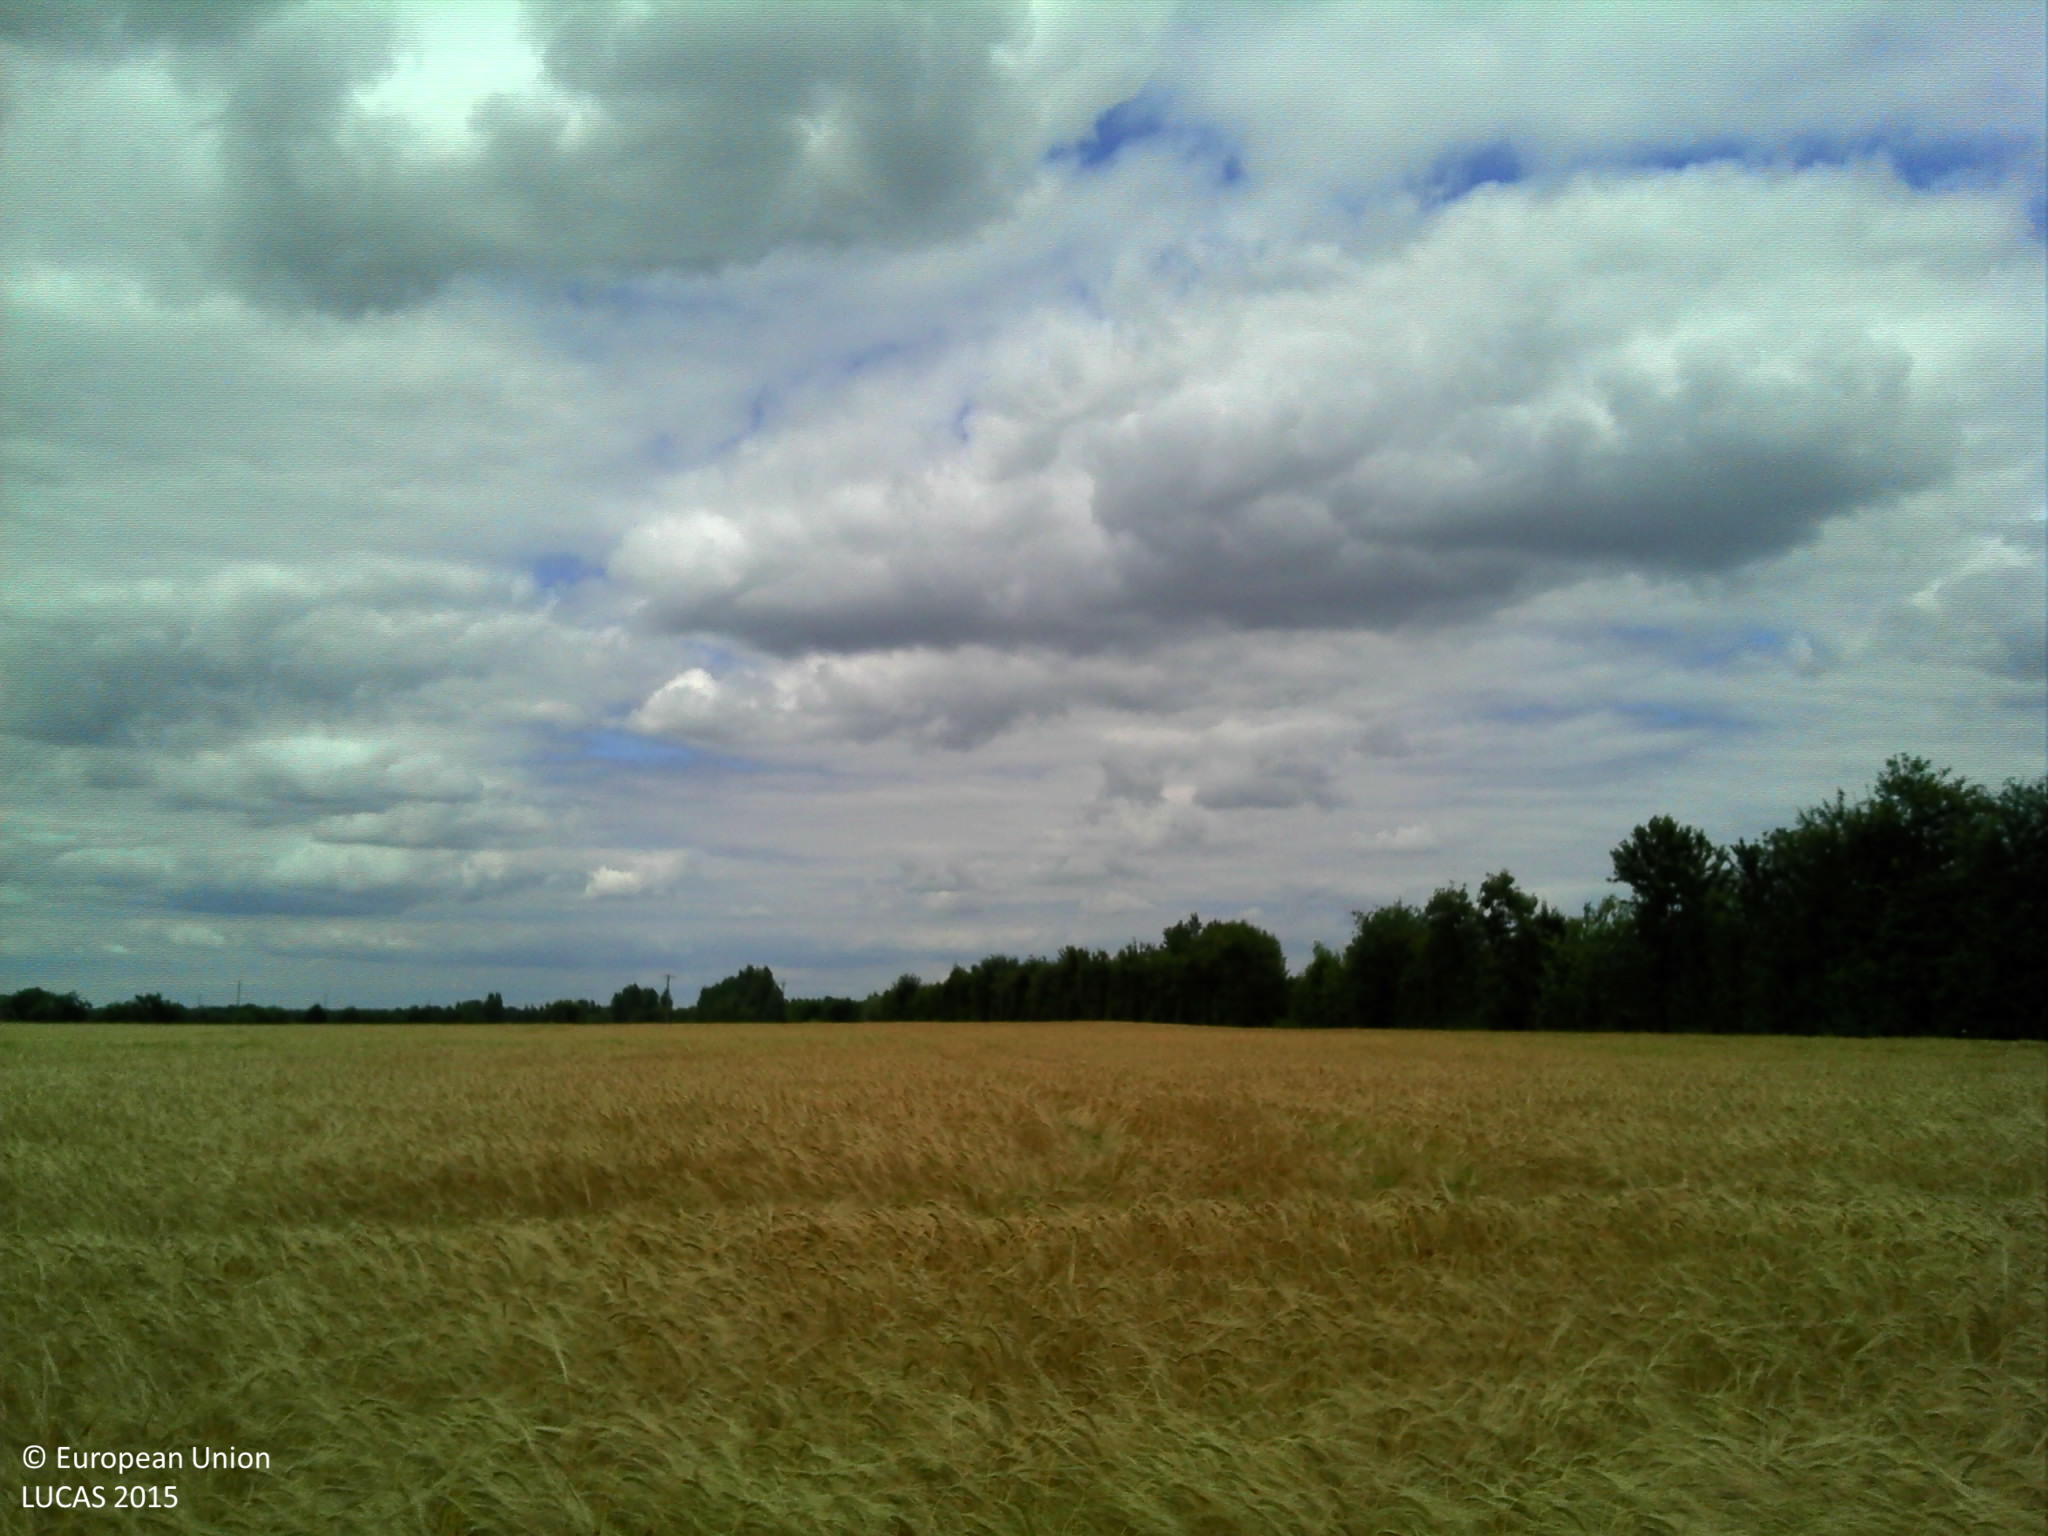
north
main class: Cropland
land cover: Common wheat
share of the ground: > 75 %
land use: Agriculture (excluding fallow land and kitchen gardens)
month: June
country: FR
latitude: 47.9039
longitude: 0.3031
